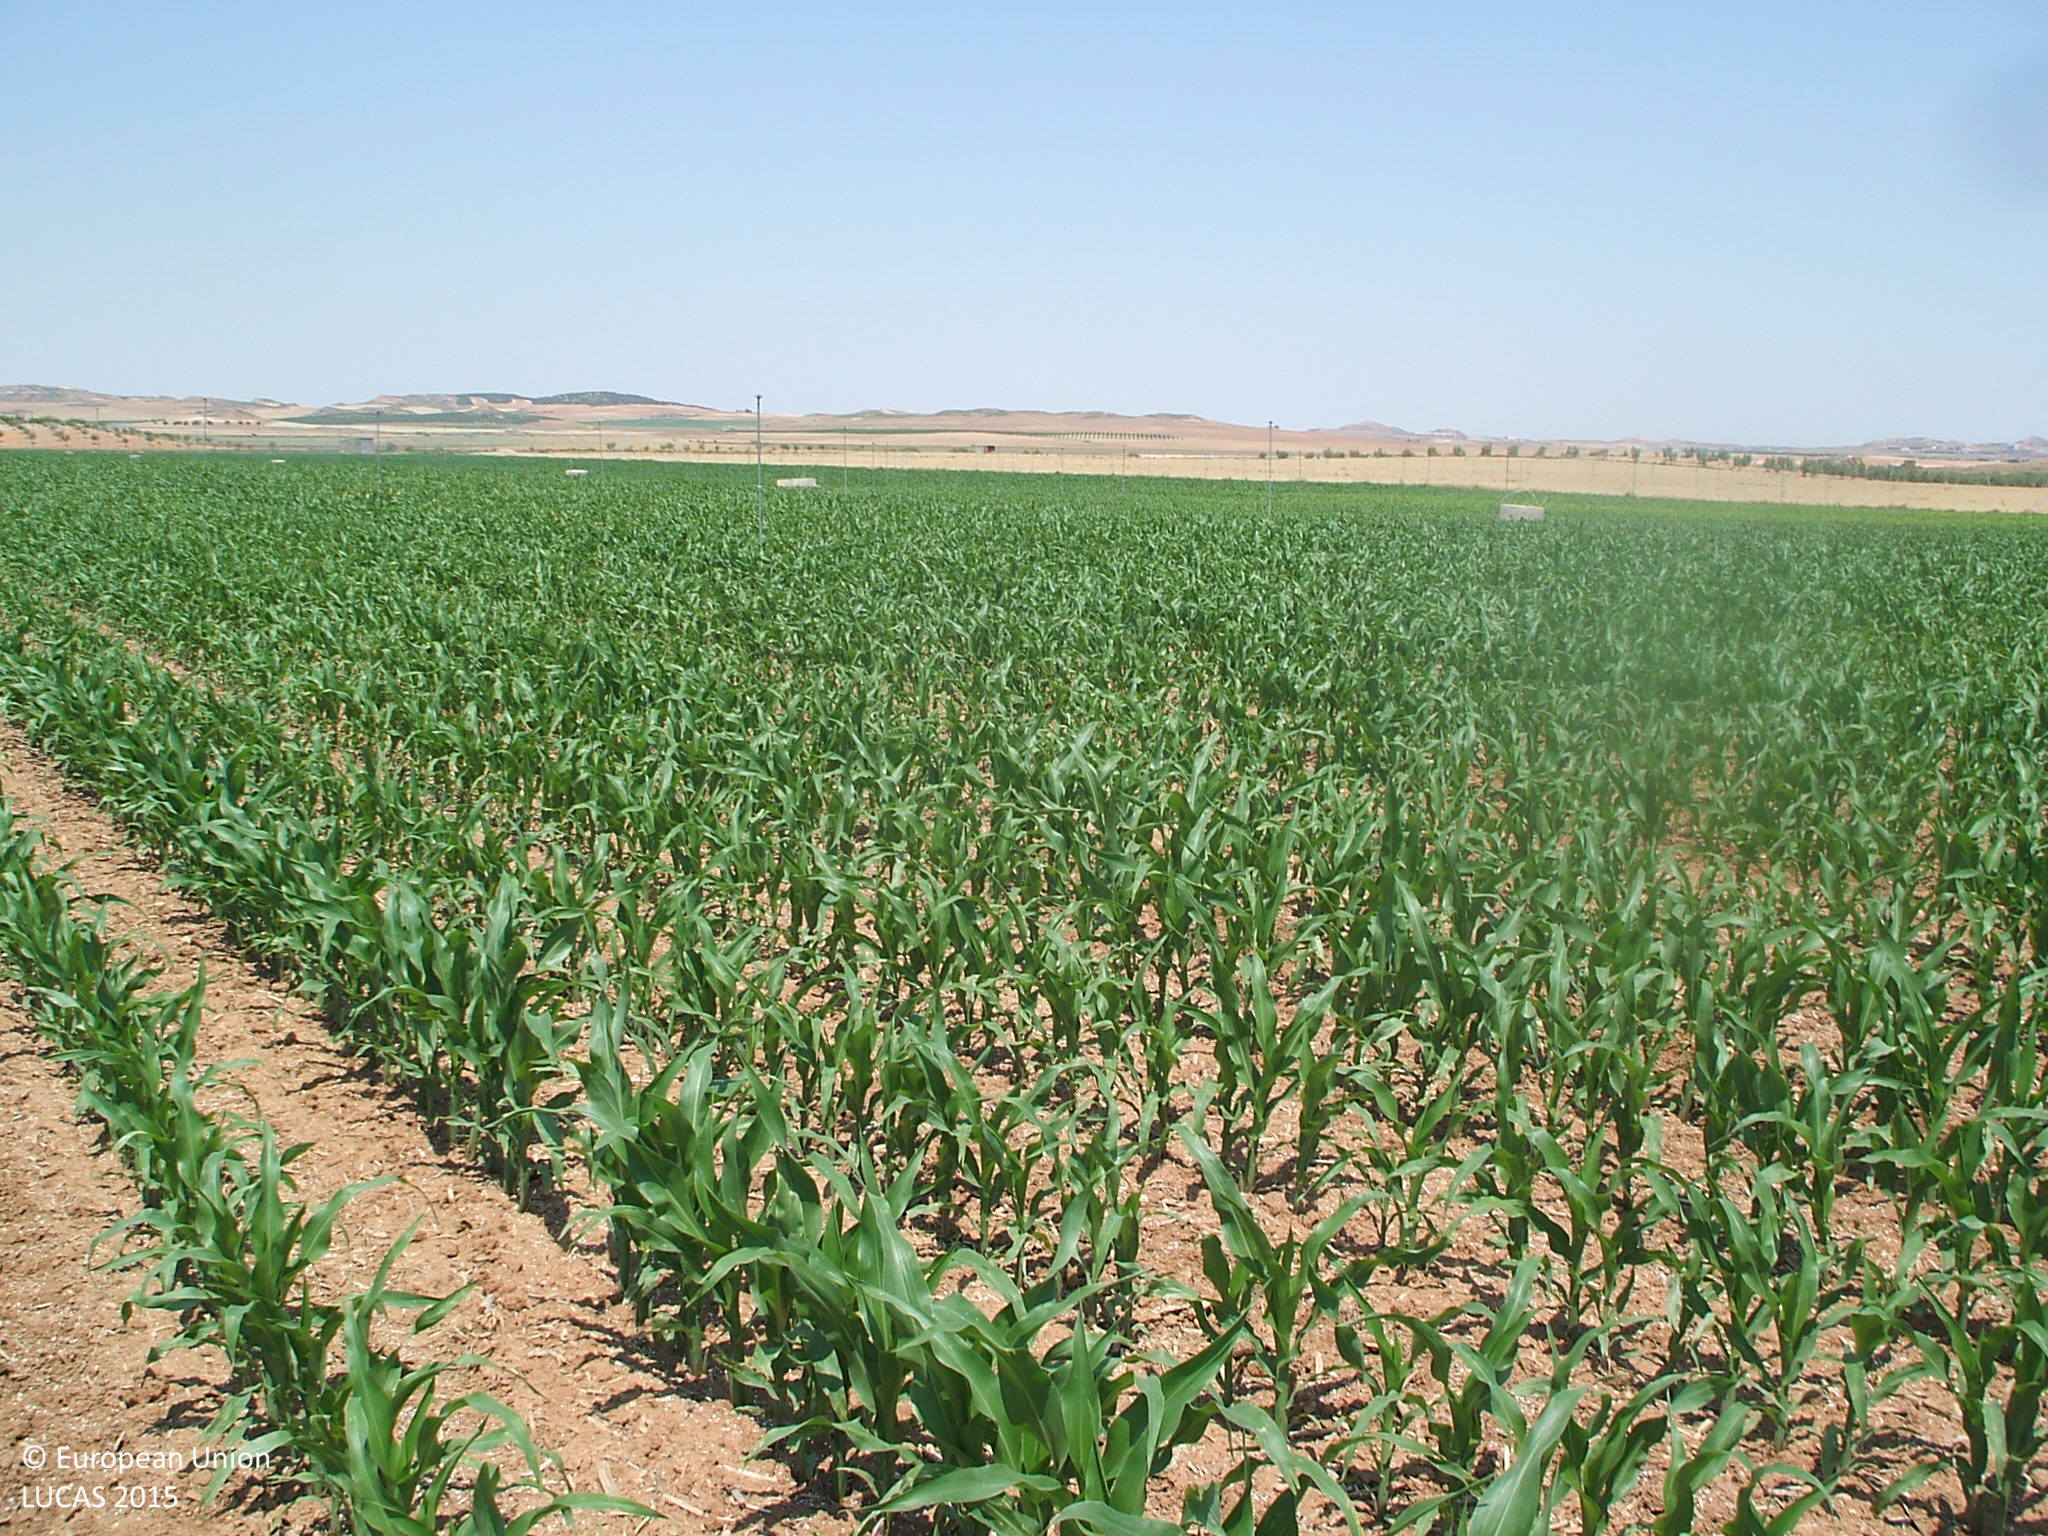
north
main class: Cropland
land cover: Maize
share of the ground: 50 - 75 %
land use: Agriculture (excluding fallow land and kitchen gardens)
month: June
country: ES
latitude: 41.0273
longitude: -0.2042
